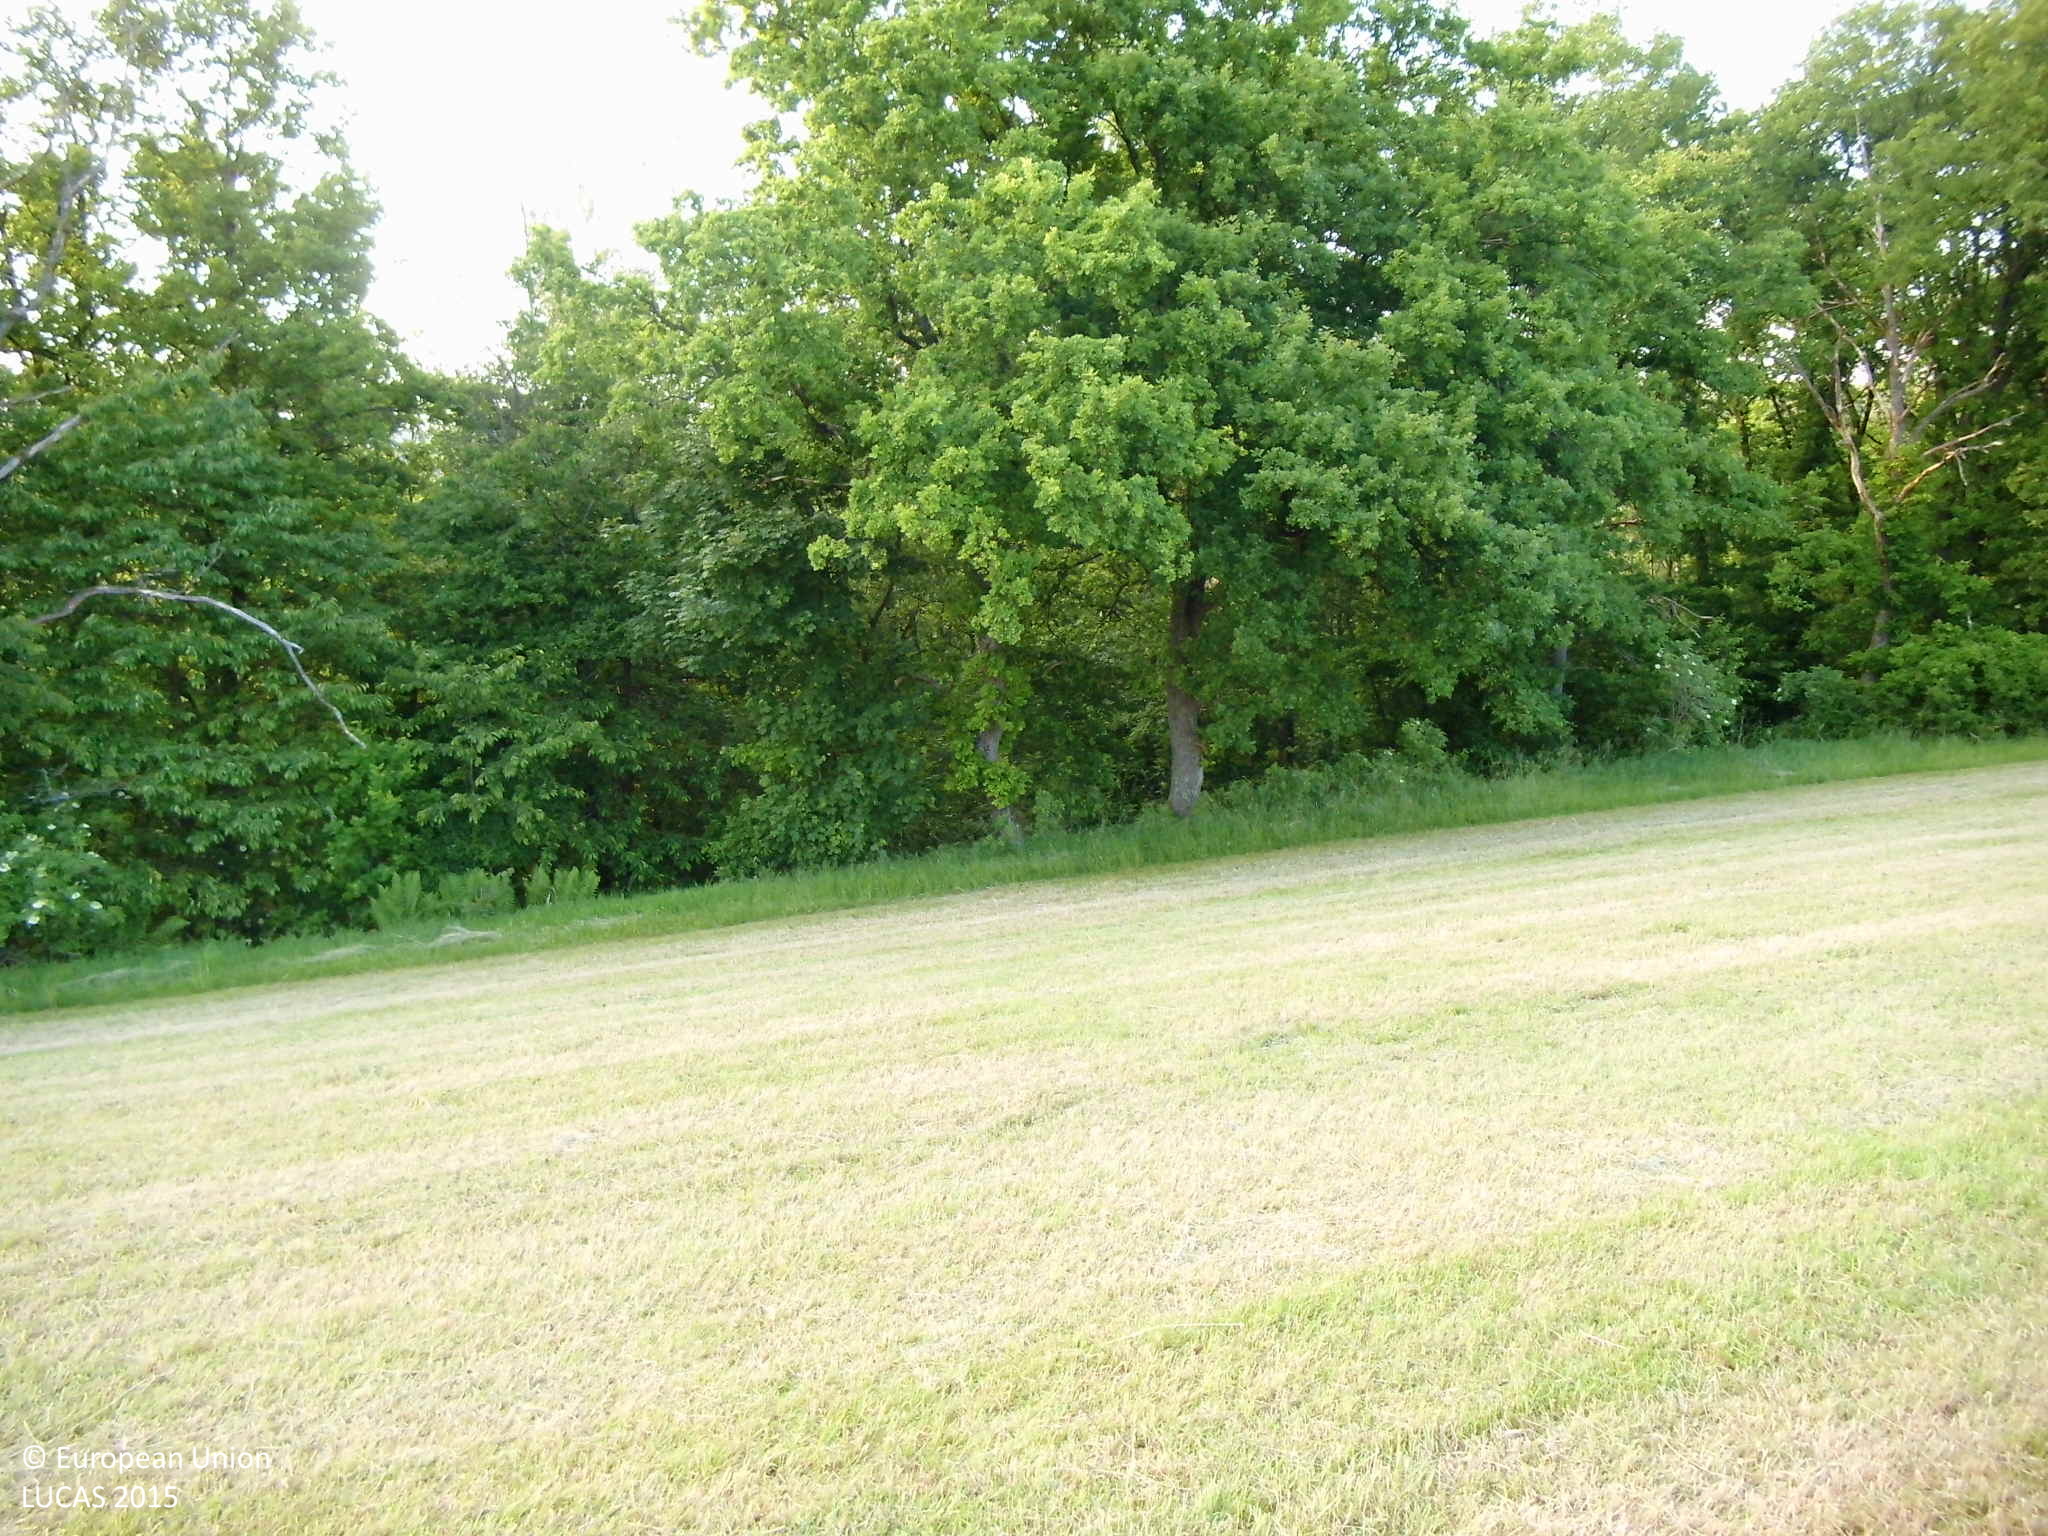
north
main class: Grassland
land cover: Grassland without tree/shrub cover
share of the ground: > 75 %
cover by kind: herbaceous plants 100 %
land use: Agriculture (excluding fallow land and kitchen gardens)
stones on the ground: 10 - 25 %
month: June
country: DE
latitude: 50.9235
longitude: 8.0798
